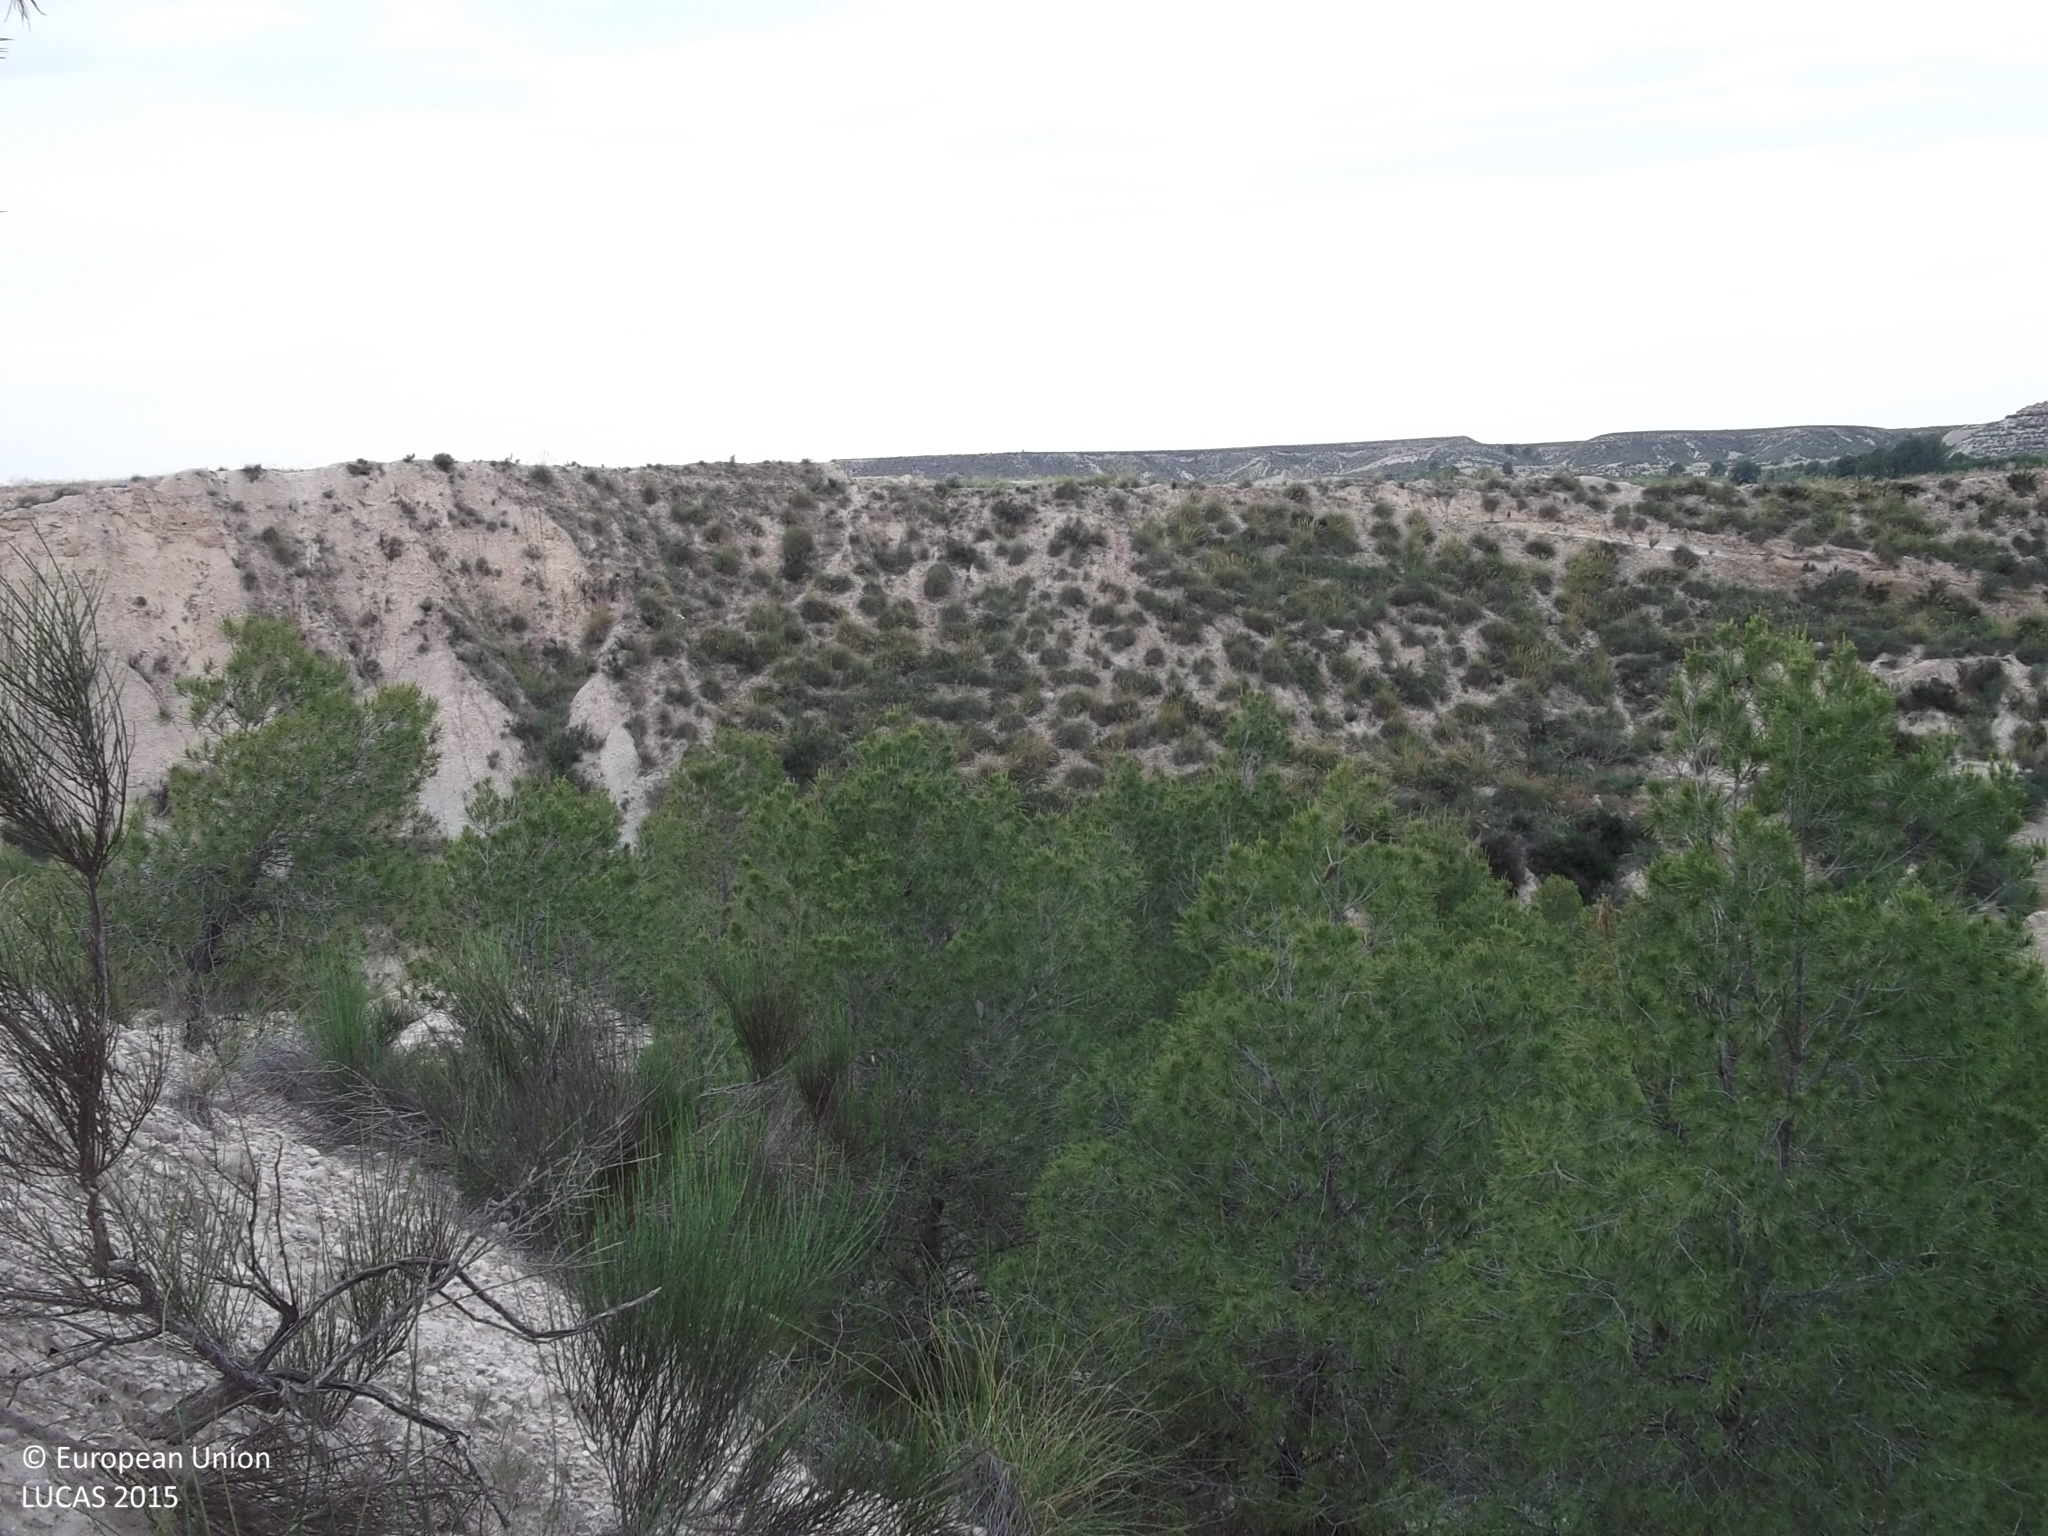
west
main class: Woodland
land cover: Pine dominated coniferous woodland
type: coniferous forest of the mediterranean region
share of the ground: 10 - 25 %
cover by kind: shrubs 40 %, consolidated bare surface 40 %, coniferous forest trees 20 %
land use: Semi-natural and natural areas not in use
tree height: < 5 m
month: May
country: ES
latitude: 38.2992
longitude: -1.4353
